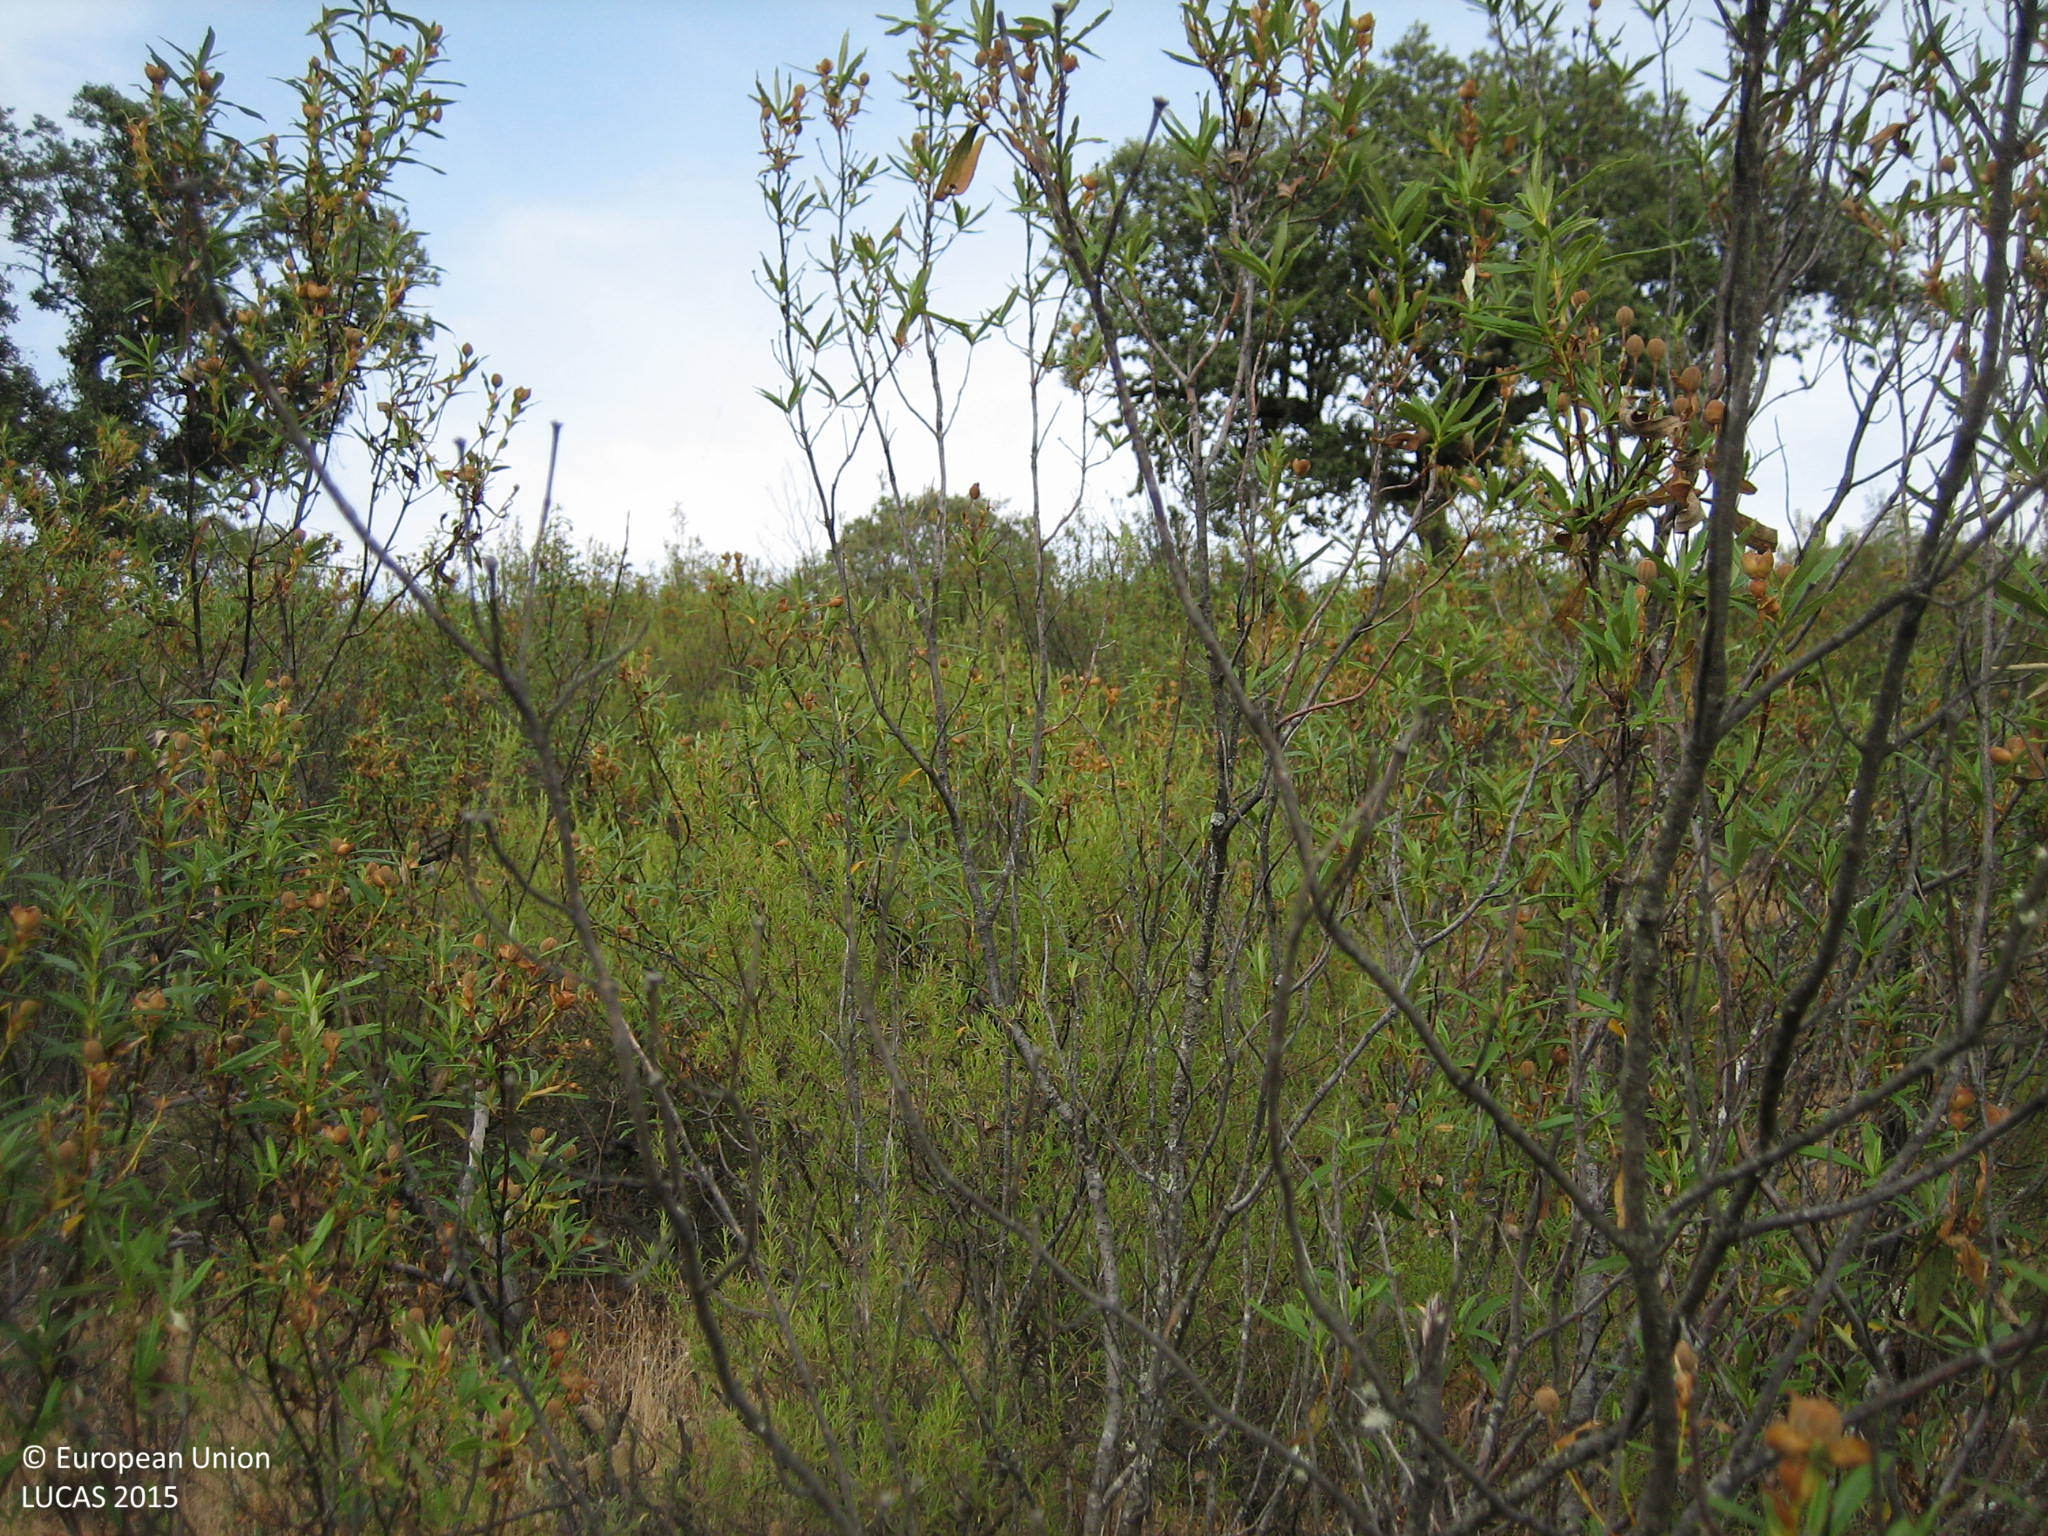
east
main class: Shrubland
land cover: Shrubland with sparse tree cover
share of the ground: > 75 %
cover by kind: shrubs 95 %, broadleaved forest trees 5 %
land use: Semi-natural and natural areas not in use
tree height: < 5 m
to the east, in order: Shrubland with sparse tree cover; Fences; Shrubland with sparse tree cover
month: June
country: ES
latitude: 39.3211
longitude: -4.9214
